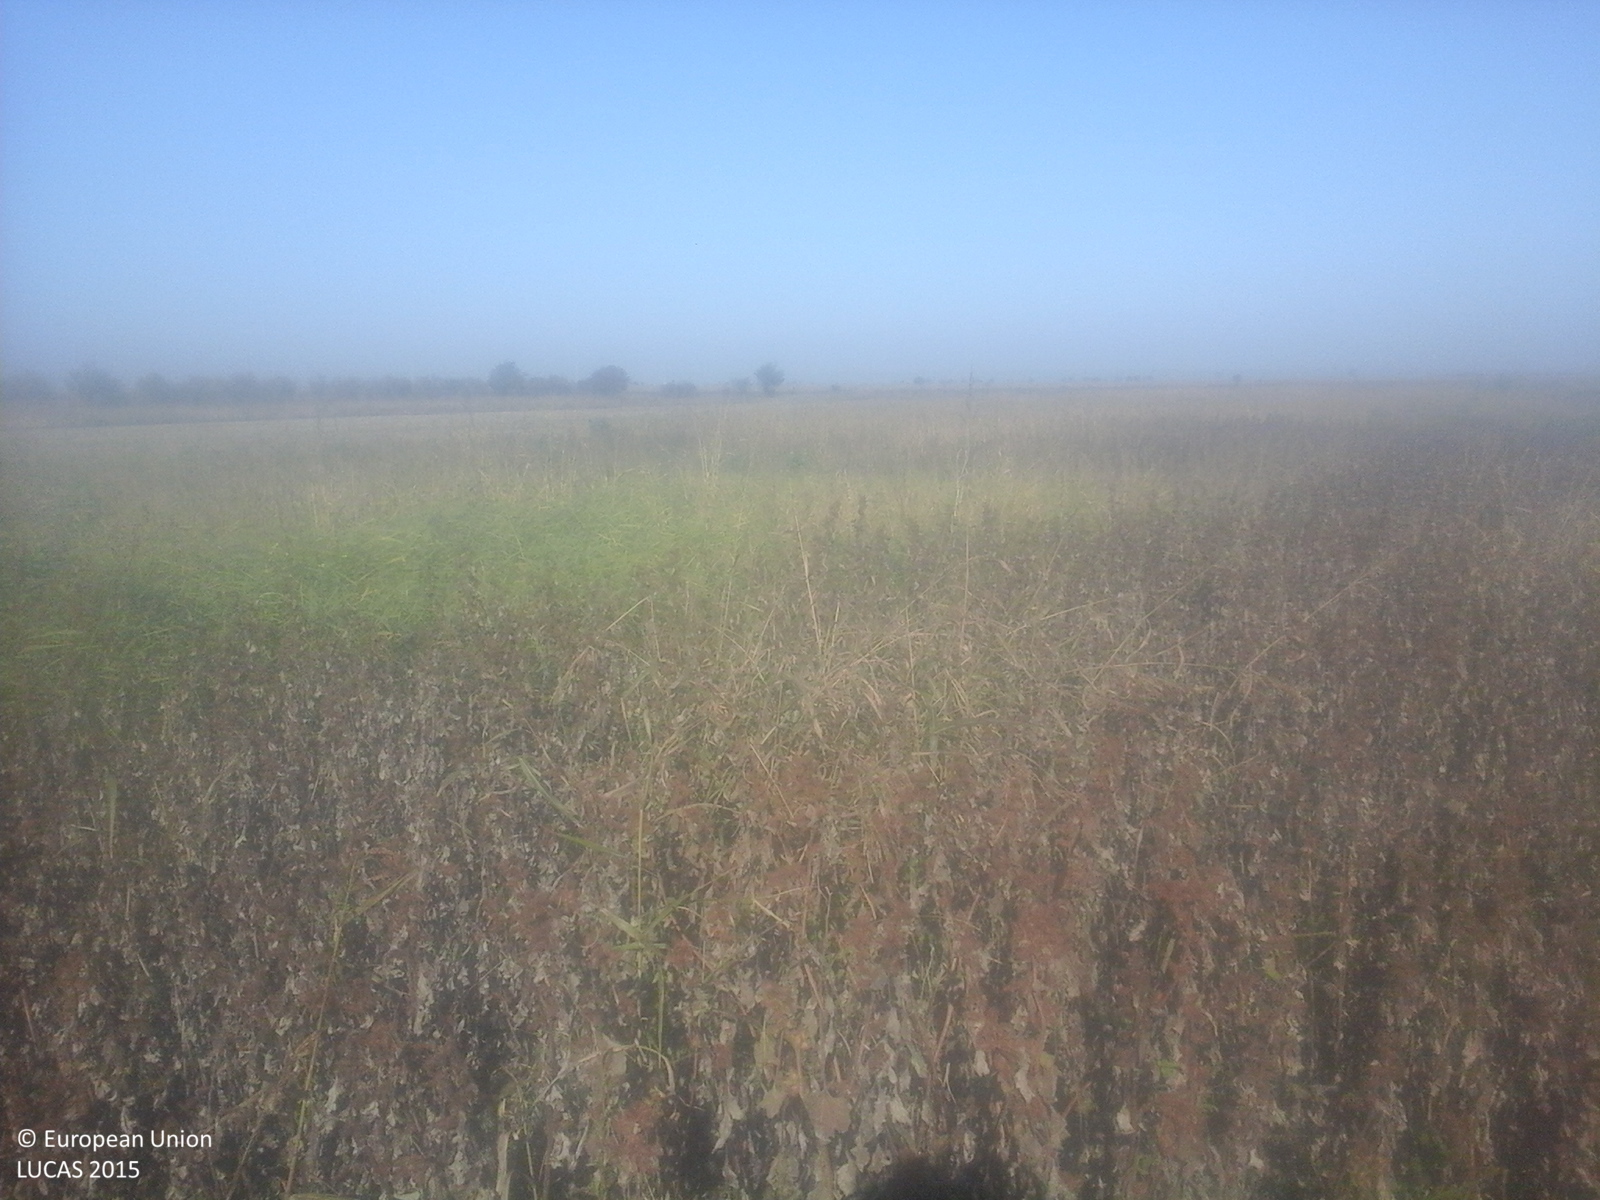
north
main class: Grassland
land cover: Spontaneously vegetated surfaces
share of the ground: > 75 %
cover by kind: herbaceous plants 100 %
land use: Fallow land
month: October
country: RO
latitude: 45.8311
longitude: 27.1787
